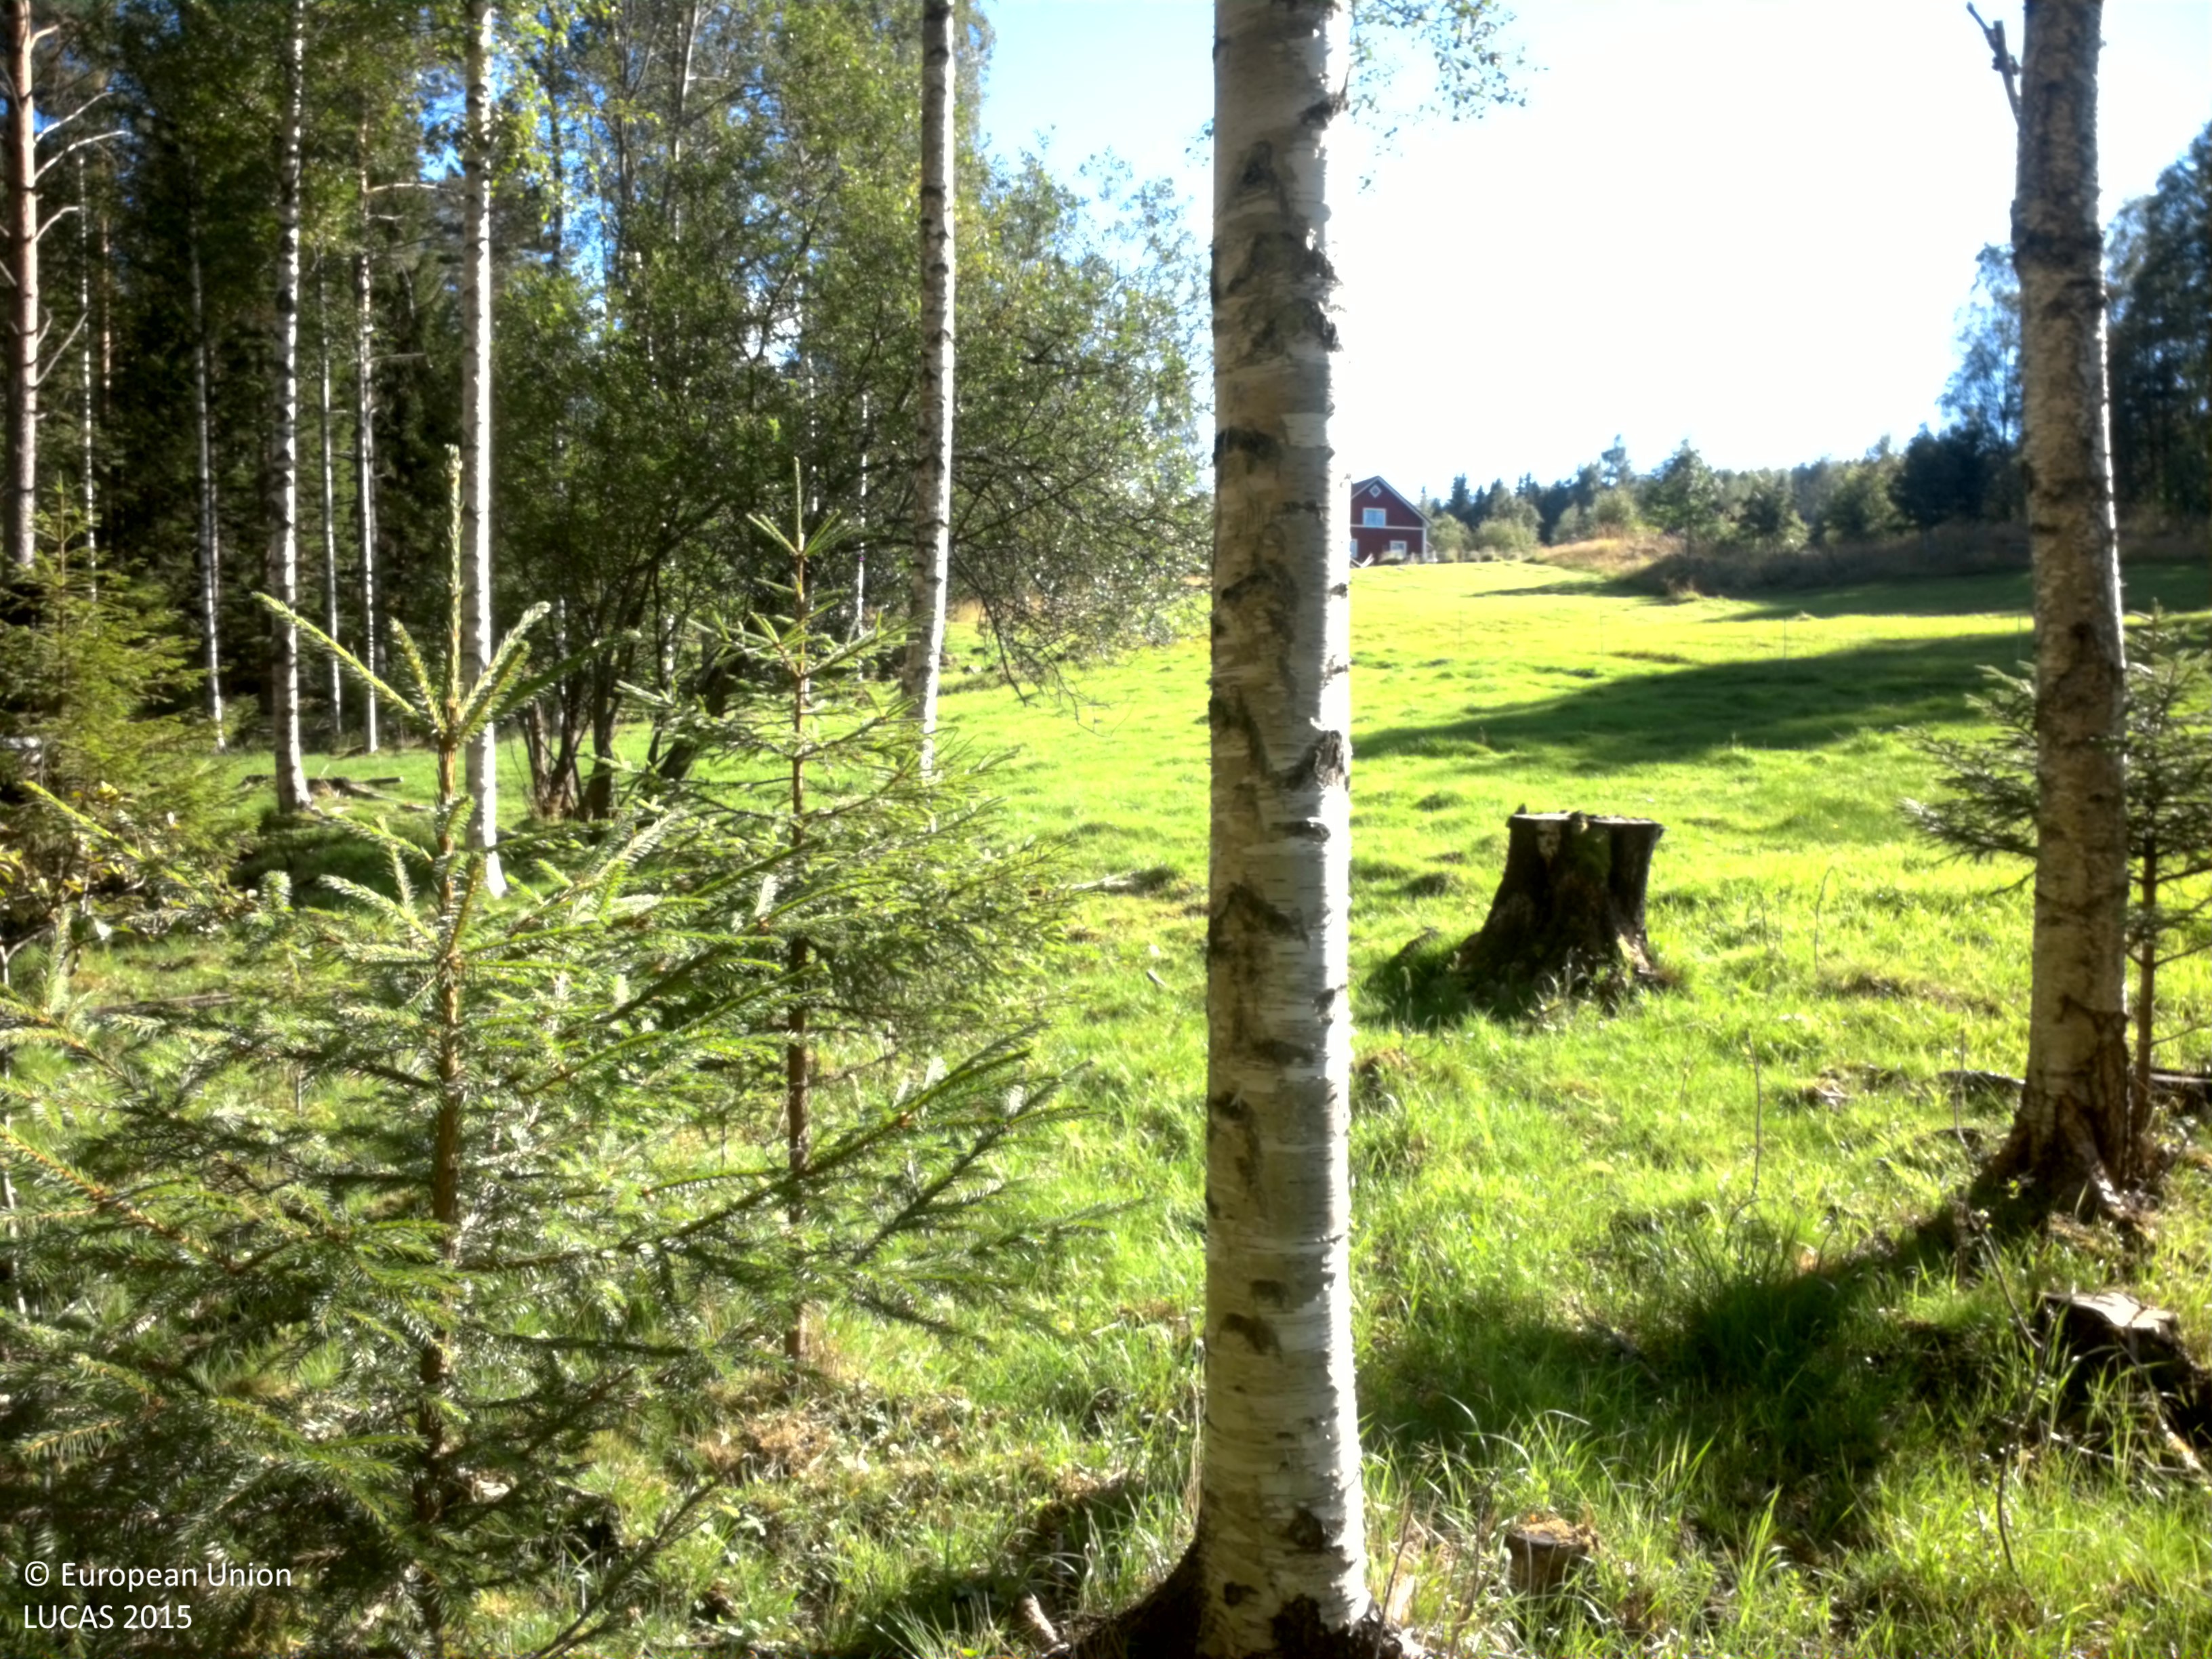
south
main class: Woodland
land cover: Broadleaved woodland
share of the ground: 50 - 75 %
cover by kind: broadleaved forest trees 50 %, herbaceous plants 40 %, coniferous forest trees 10 %
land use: Agriculture (excluding fallow land and kitchen gardens)
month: August
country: SE
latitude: 59.9369
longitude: 14.2314
